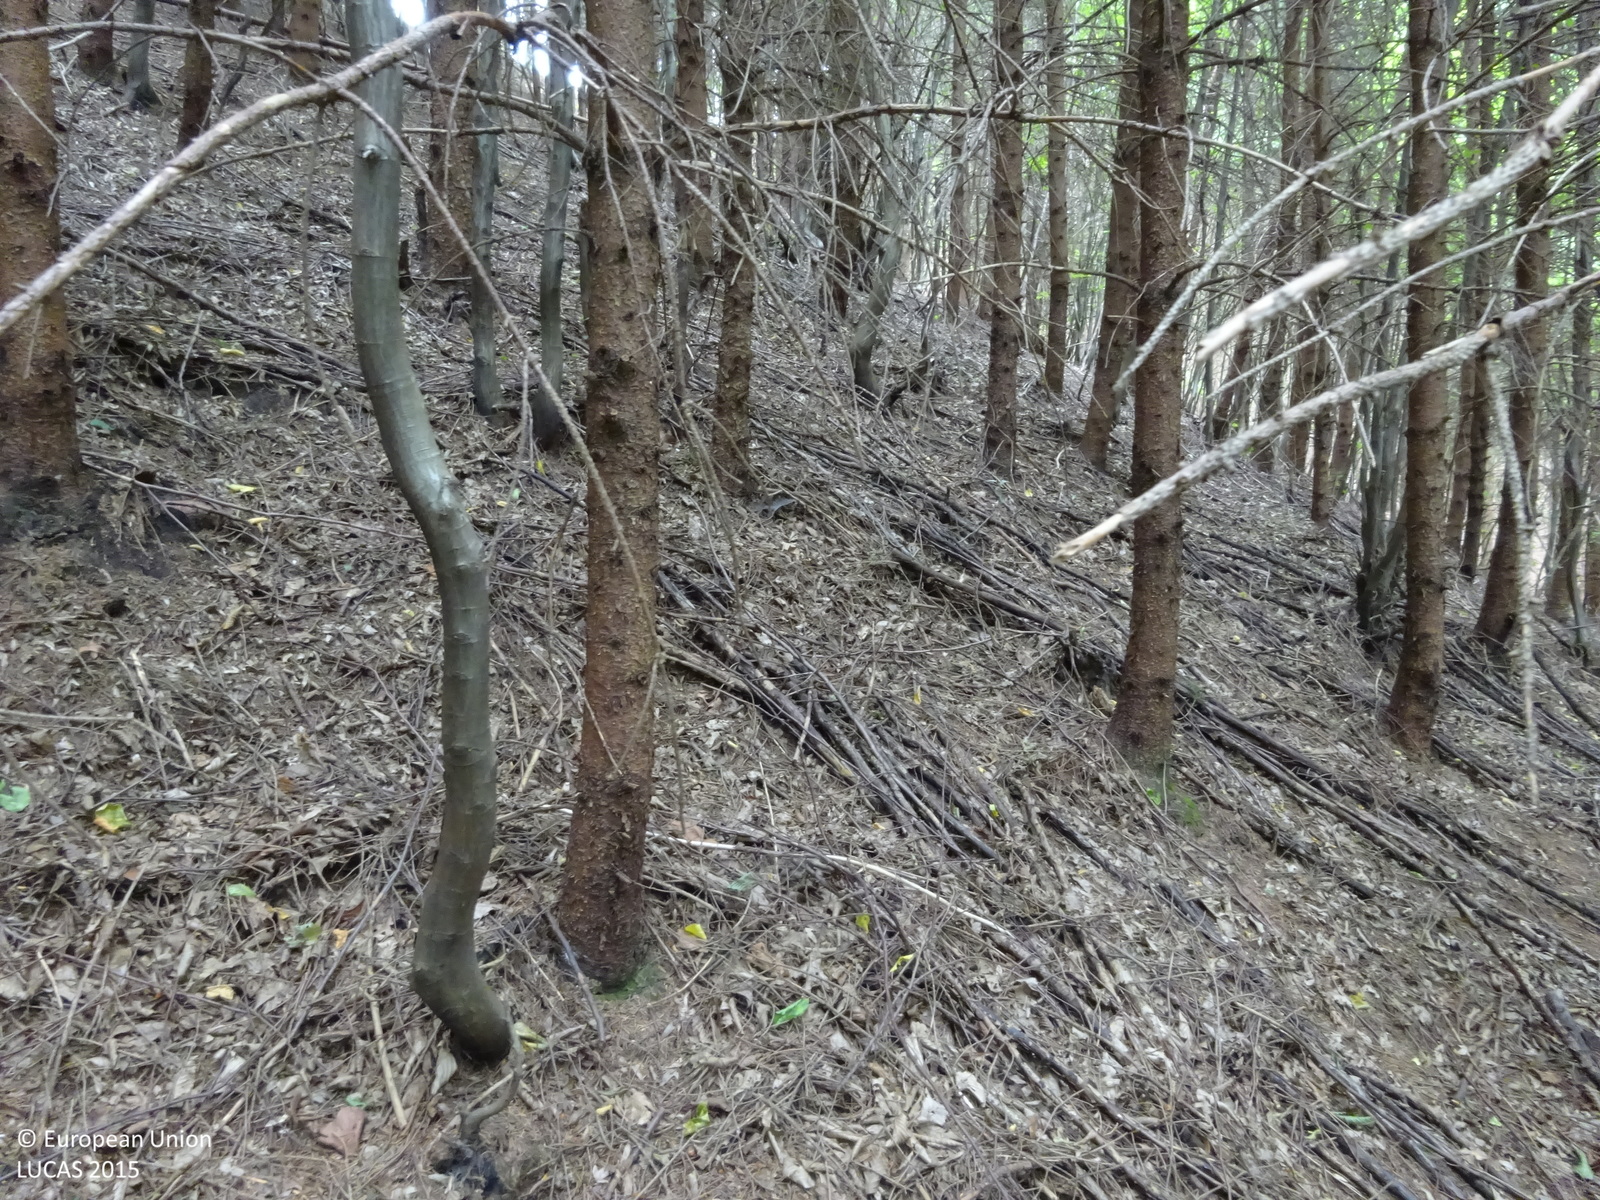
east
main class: Woodland
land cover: Spruce dominated coniferous woodland
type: alpine coniferous forest
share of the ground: > 75 %
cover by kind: coniferous forest trees 95 %, broadleaved forest trees 5 %
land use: Forestry
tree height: > 5 m
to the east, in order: Spruce dominated coniferous woodland; Tracks; Spruce dominated coniferous woodland; Shrubland without tree cover; Fences; Grassland with sparse tree/shrub cover; Fences; Grassland without tree/shrub cover; Fences; Spruce dominated coniferous woodland
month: July
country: AT
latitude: 47.0381
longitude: 15.1714
